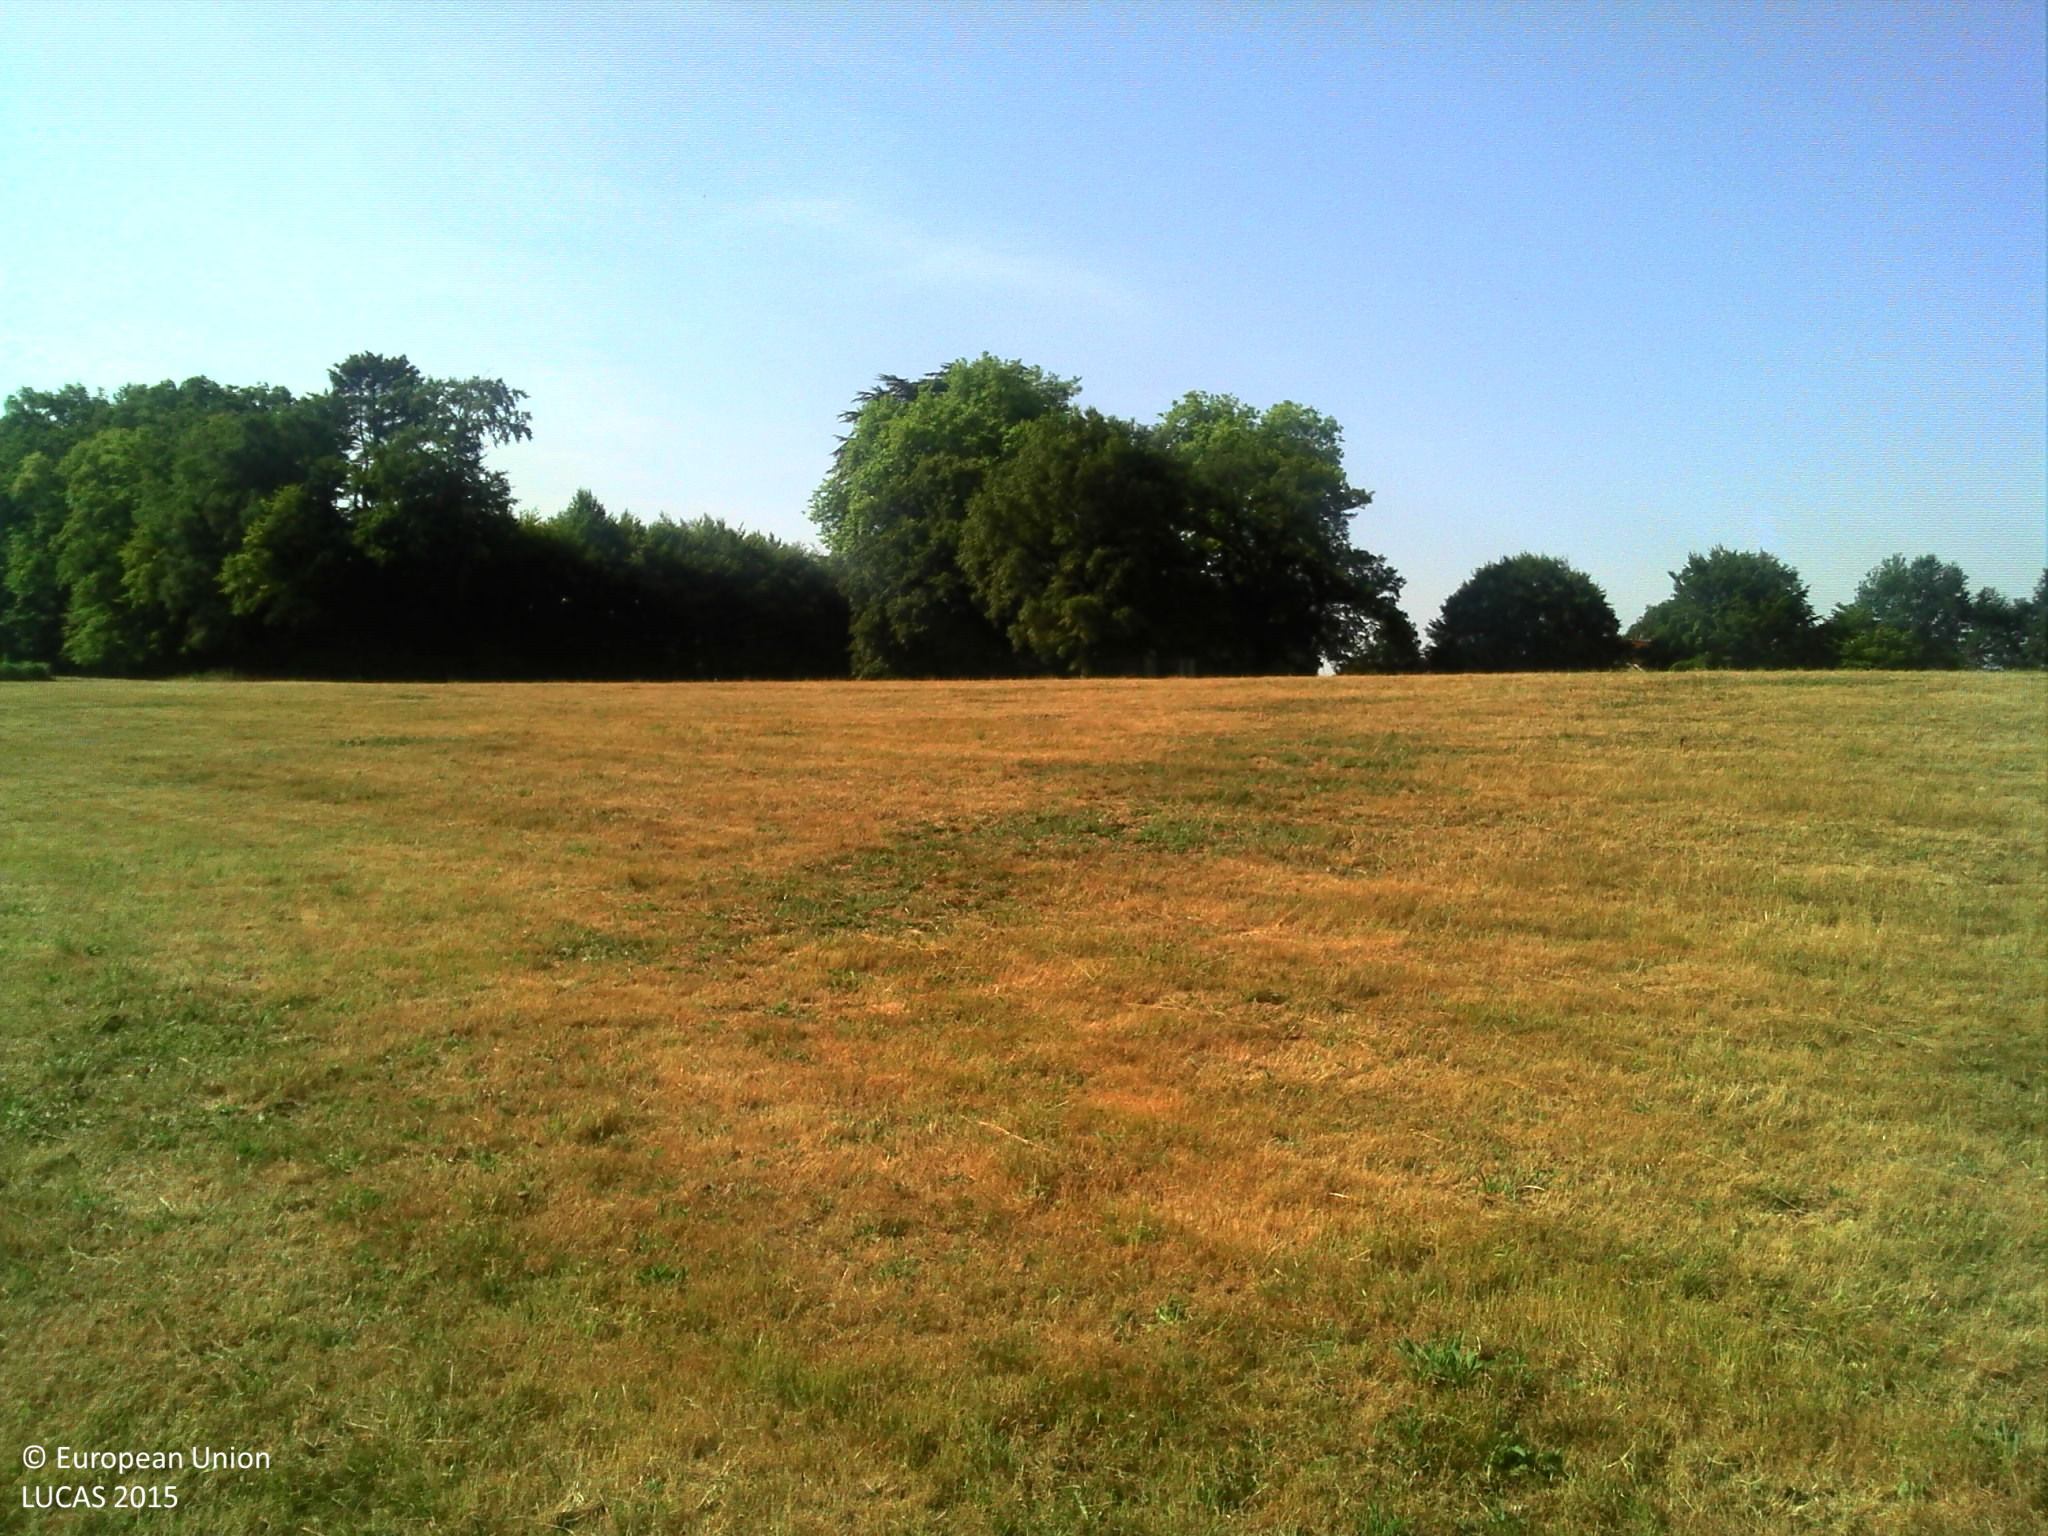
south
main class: Grassland
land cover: Grassland without tree/shrub cover
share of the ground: > 75 %
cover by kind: herbaceous plants 100 %
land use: Agriculture (excluding fallow land and kitchen gardens)
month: July
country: FR
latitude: 45.9933
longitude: 1.7170
